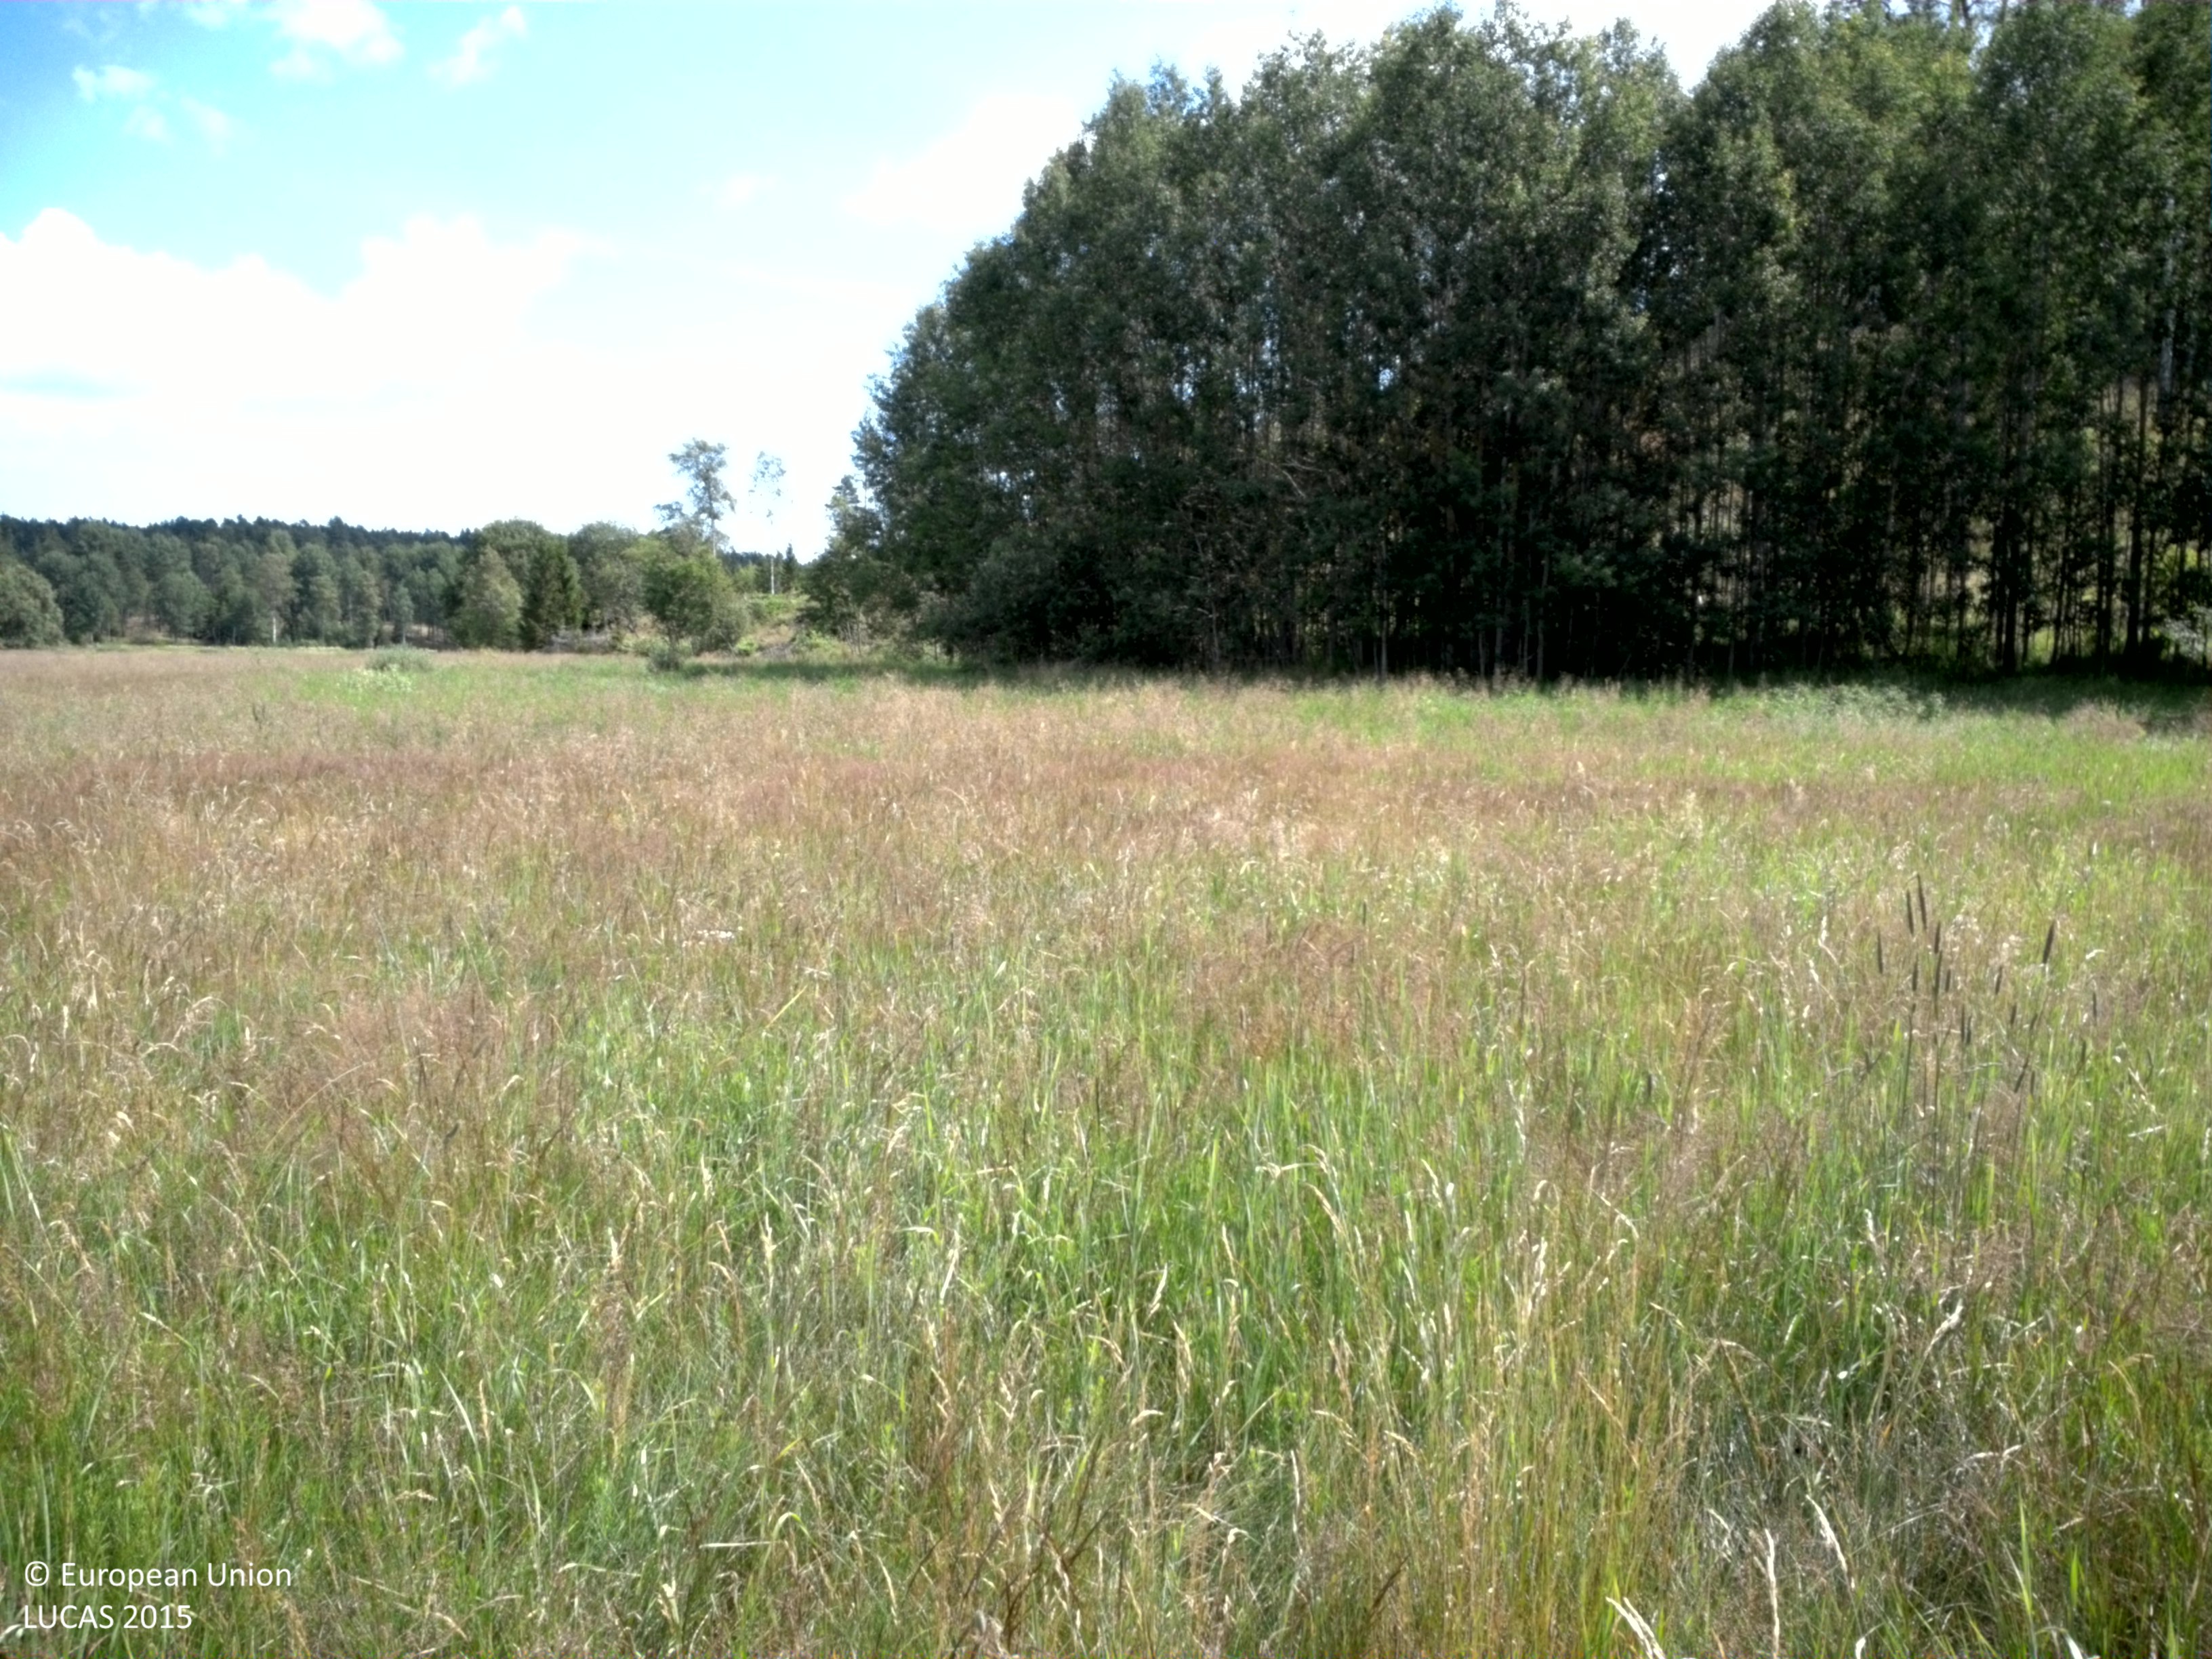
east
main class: Grassland
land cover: Grassland without tree/shrub cover
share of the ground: > 75 %
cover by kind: herbaceous plants 100 %
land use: Agriculture (excluding fallow land and kitchen gardens)
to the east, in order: Grassland without tree/shrub cover; Ditches and canals; Grassland without tree/shrub cover; Broadleaved woodland; Spruce dominated coniferous woodland
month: July
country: SE
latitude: 59.6322
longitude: 18.5296
